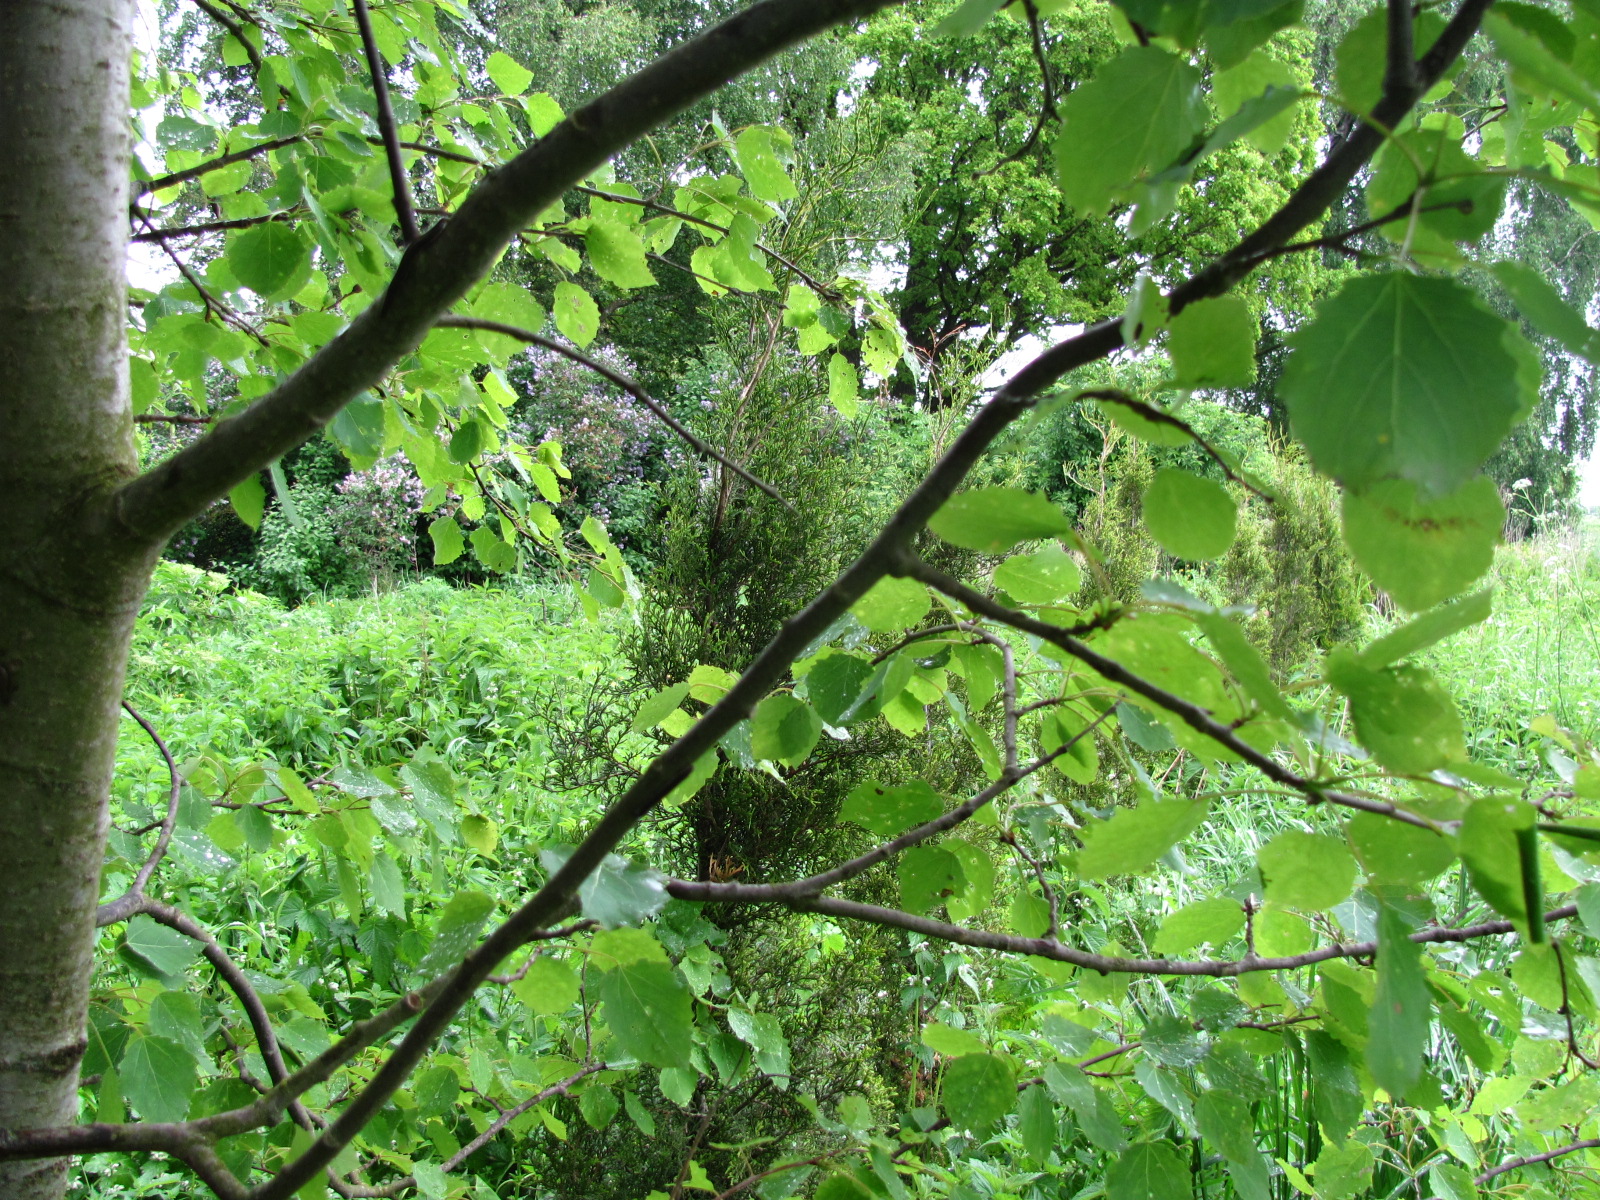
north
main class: Woodland
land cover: Broadleaved woodland
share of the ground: > 75 %
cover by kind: broadleaved forest trees 100 %
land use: Residential
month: June
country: LV
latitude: 56.5951
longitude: 24.2425
